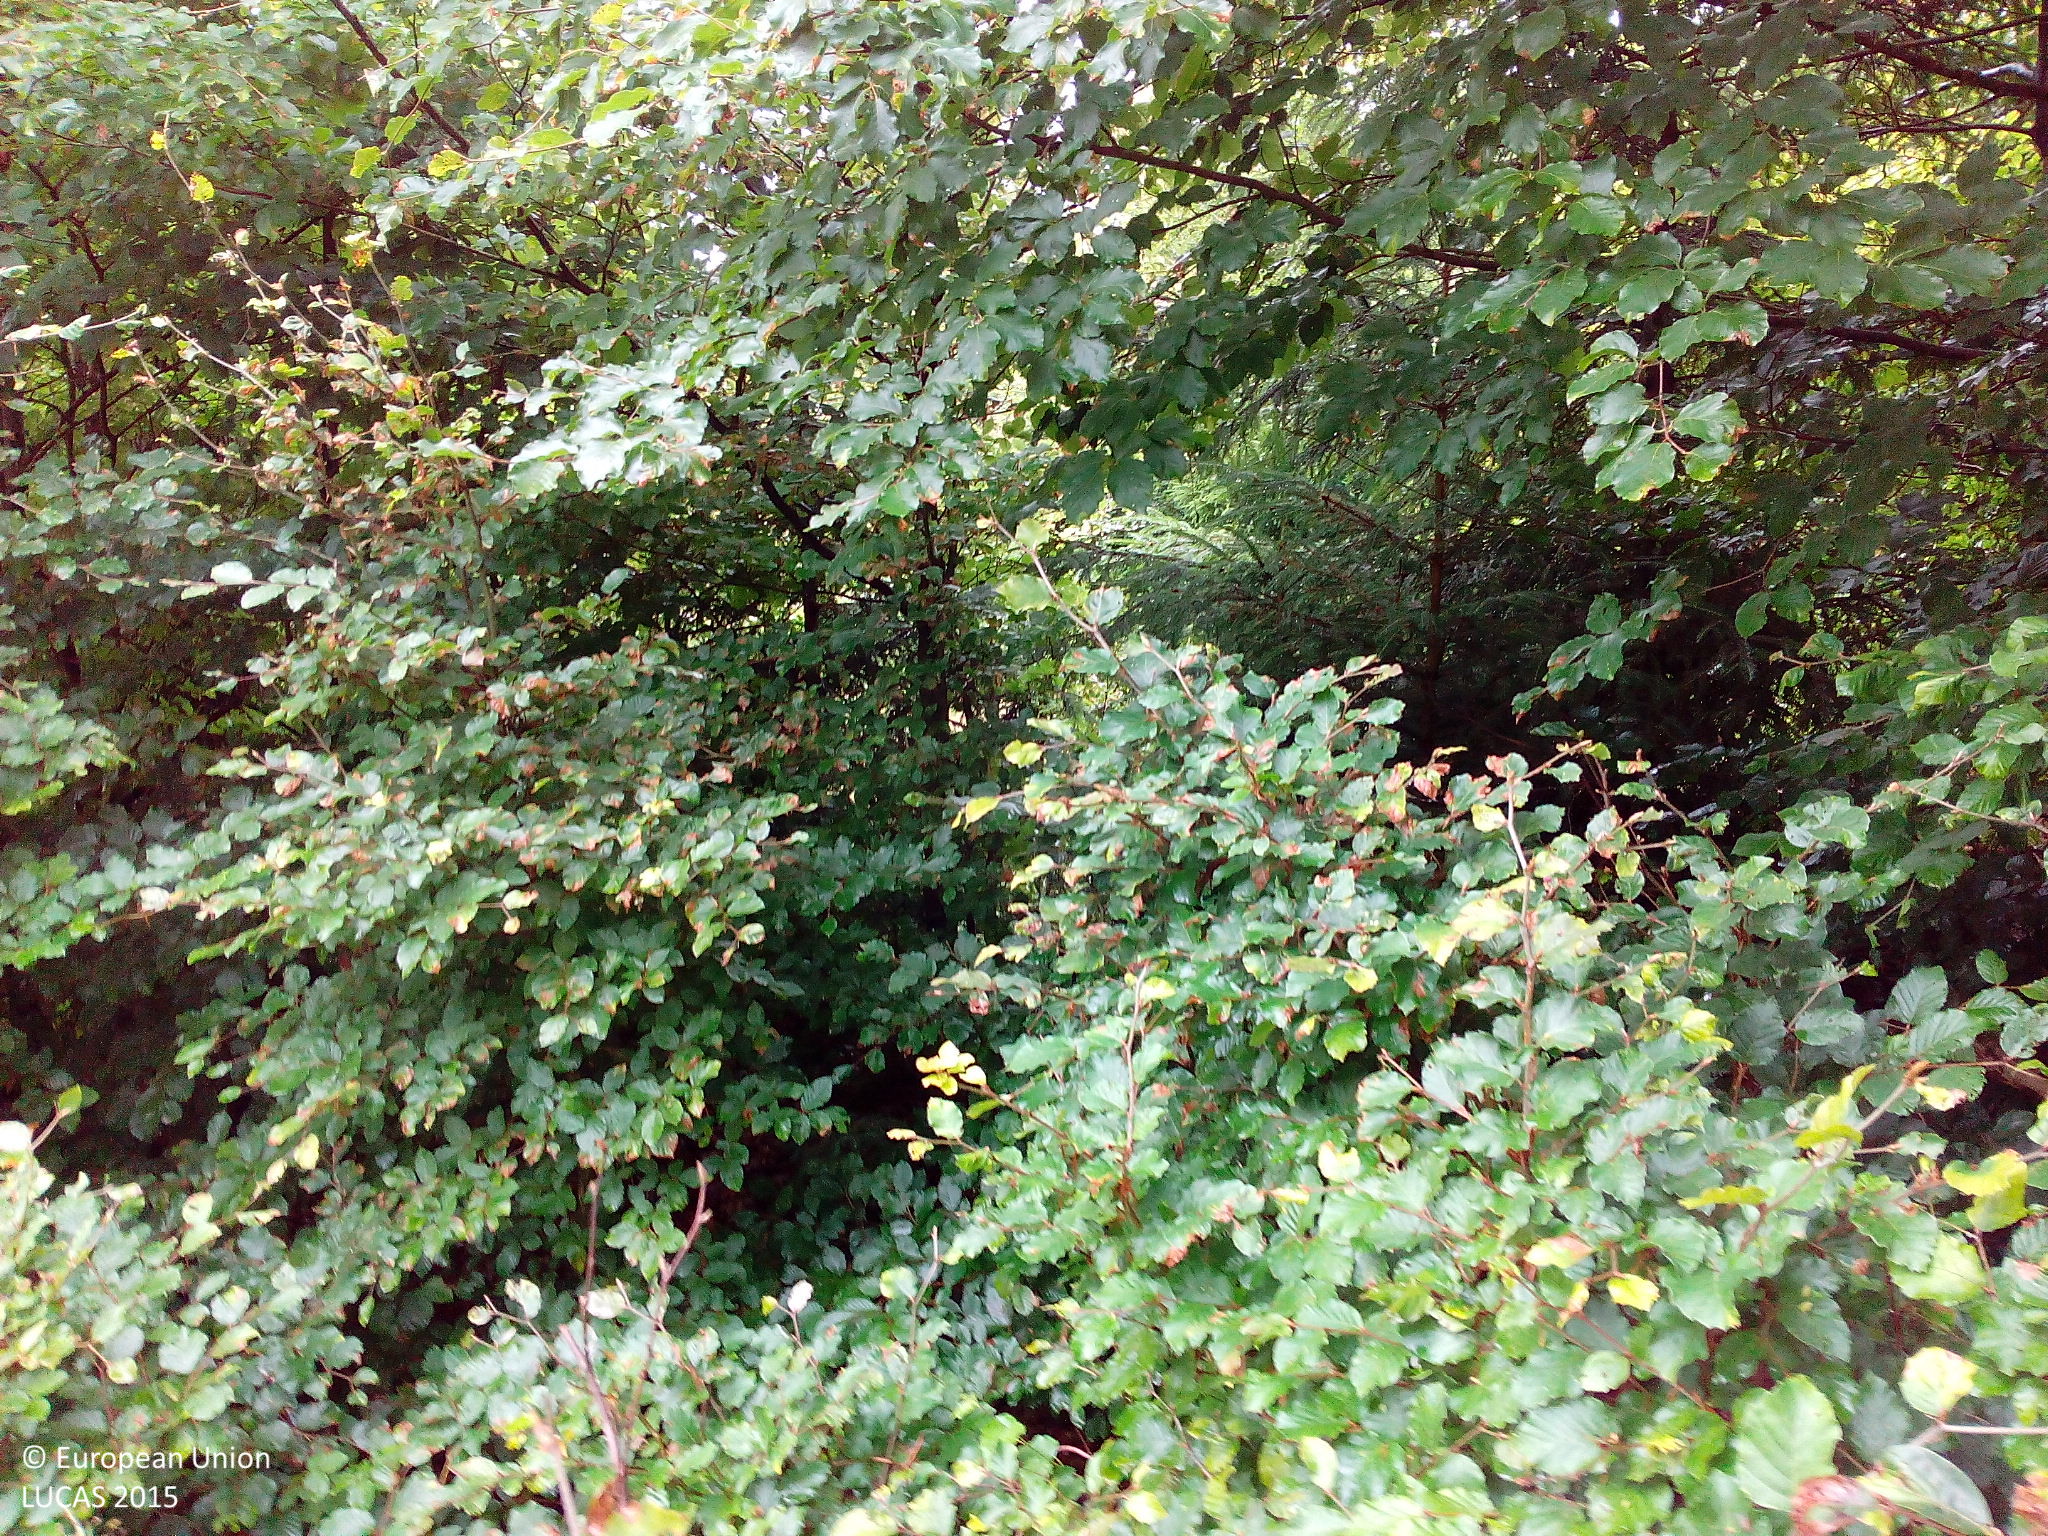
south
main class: Woodland
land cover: Broadleaved woodland
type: beech forest
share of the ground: > 75 %
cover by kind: broadleaved forest trees 95 %, herbaceous plants 5 %
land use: Forestry
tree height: > 5 m
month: July
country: DE
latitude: 50.9034
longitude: 9.9005
